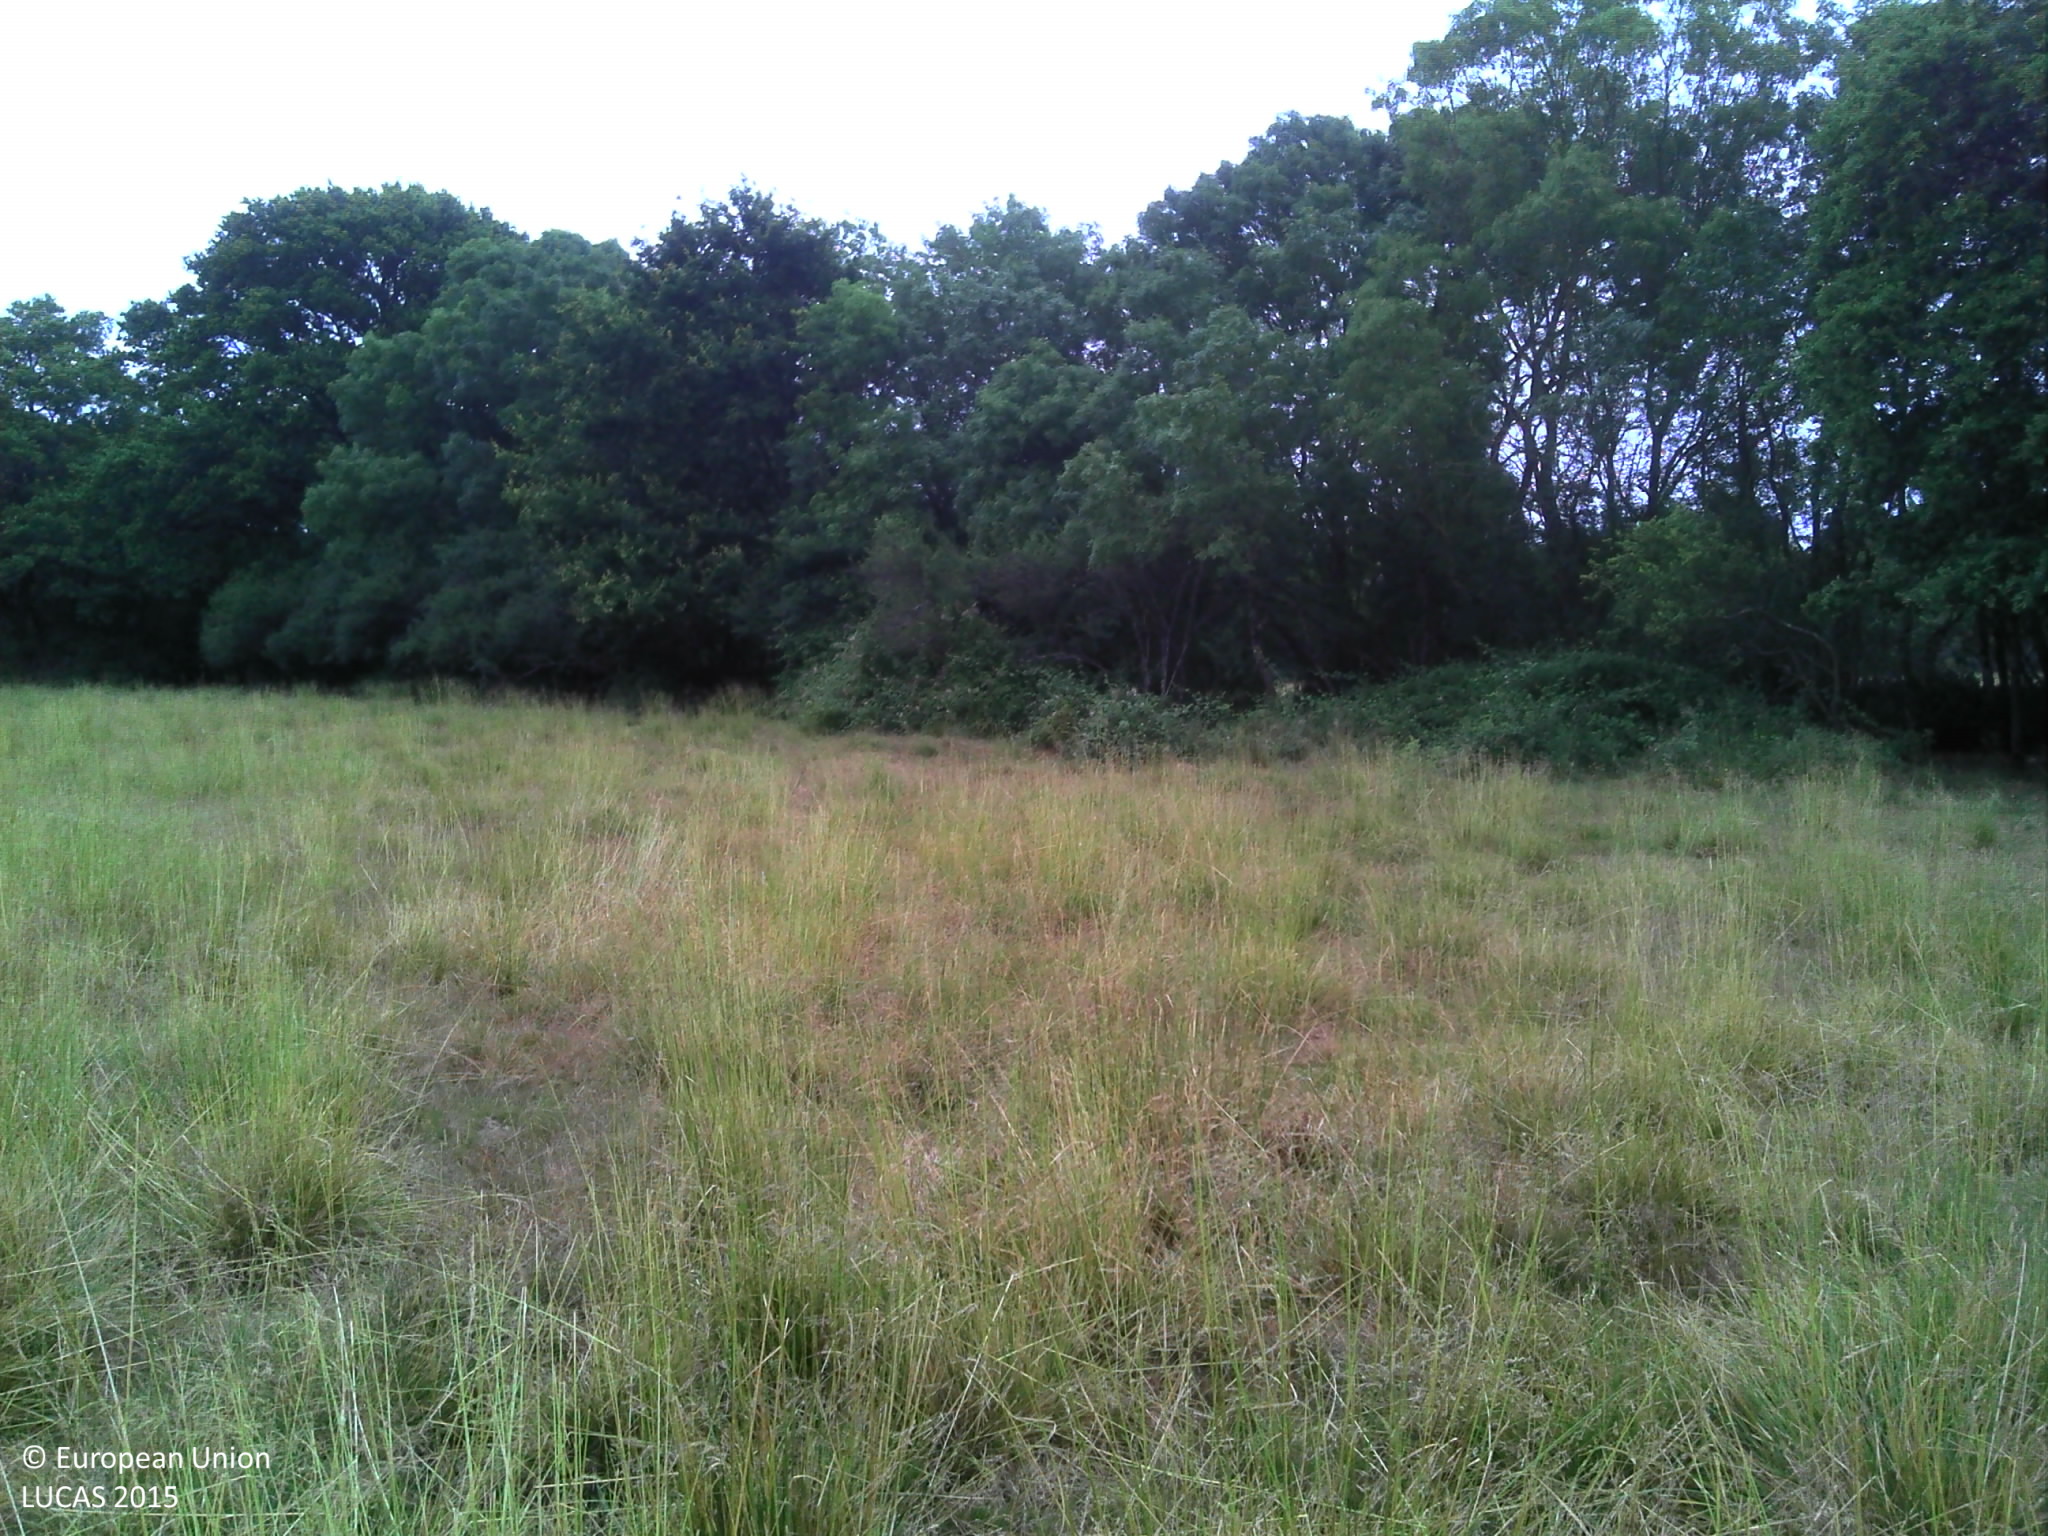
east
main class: Grassland
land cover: Grassland without tree/shrub cover
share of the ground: > 75 %
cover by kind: herbaceous plants 100 %
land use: Agriculture (excluding fallow land and kitchen gardens)
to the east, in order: Grassland without tree/shrub cover; Broadleaved woodland; Fences; Grassland without tree/shrub cover; Fences; Broadleaved woodland; Ditches and canals; Broadleaved woodland; Grassland without tree/shrub cover; Broadleaved woodland; Grassland without tree/shrub cover; Broadleaved woodland; Grassland without tree/shrub cover; Broadleaved woodland; Inland fresh water bodies; Spontaneously vegetated surfaces; Broadleaved woodland
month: July
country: FR
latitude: 47.1009
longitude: -1.7576
